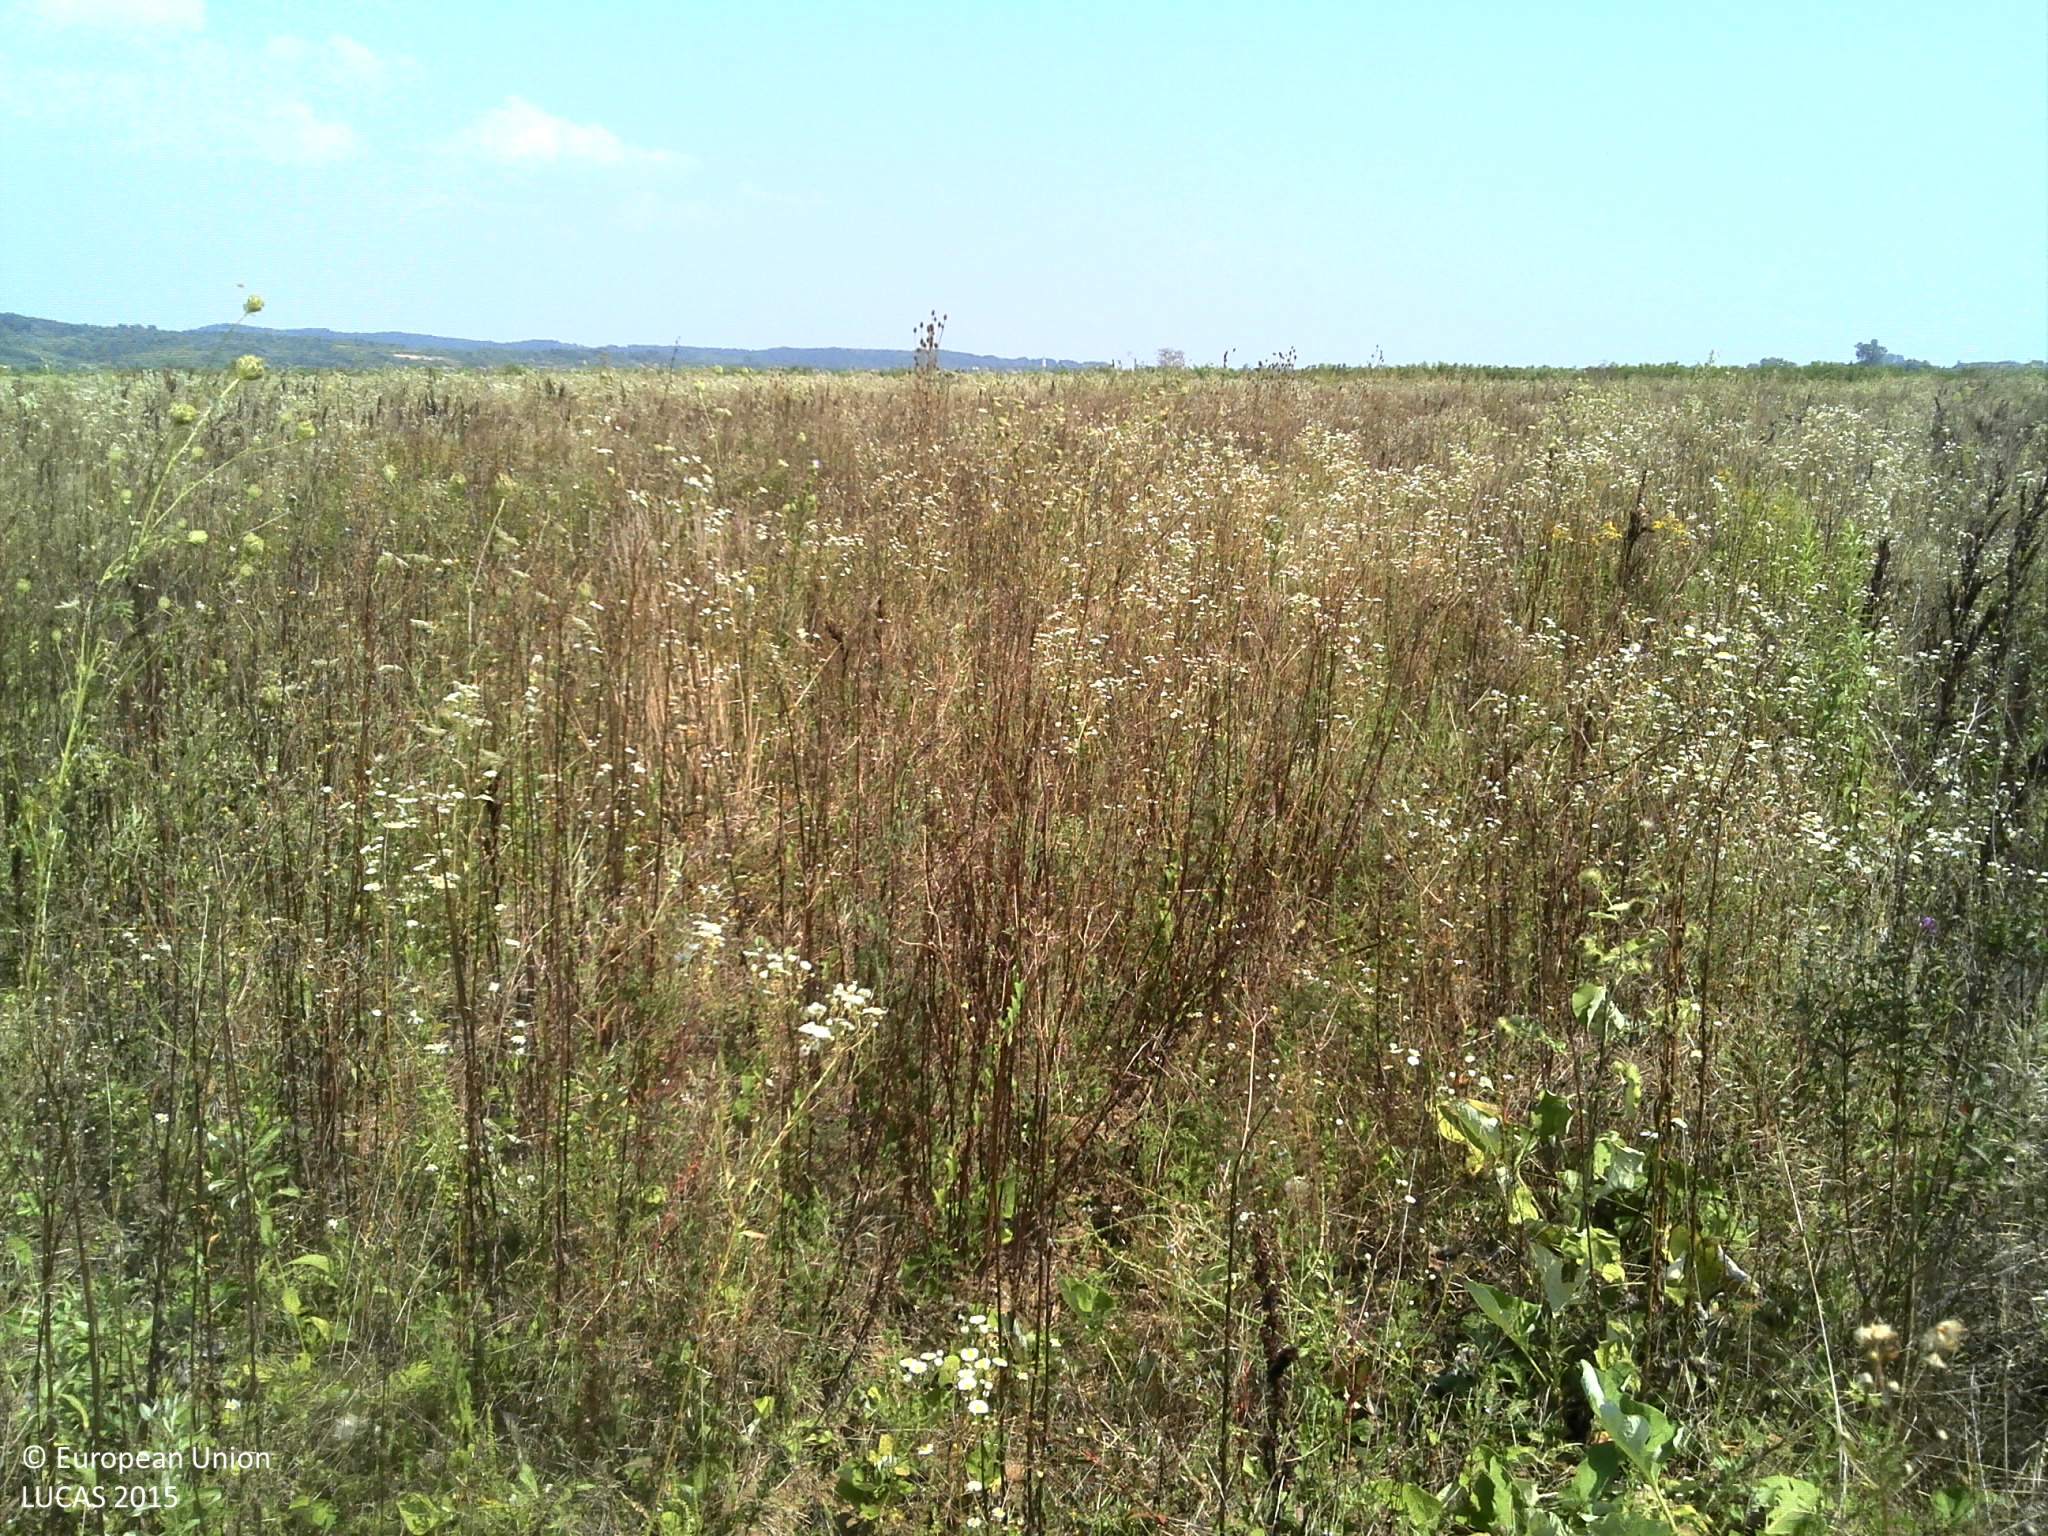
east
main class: Grassland
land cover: Spontaneously vegetated surfaces
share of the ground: > 75 %
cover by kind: herbaceous plants 100 %
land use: Fallow land
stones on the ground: < 10 %
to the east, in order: Spontaneously vegetated surfaces; Shrubland without tree cover; Ditches and canals; Spontaneously vegetated surfaces
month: August
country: HR
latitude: 45.2619
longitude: 17.1487
